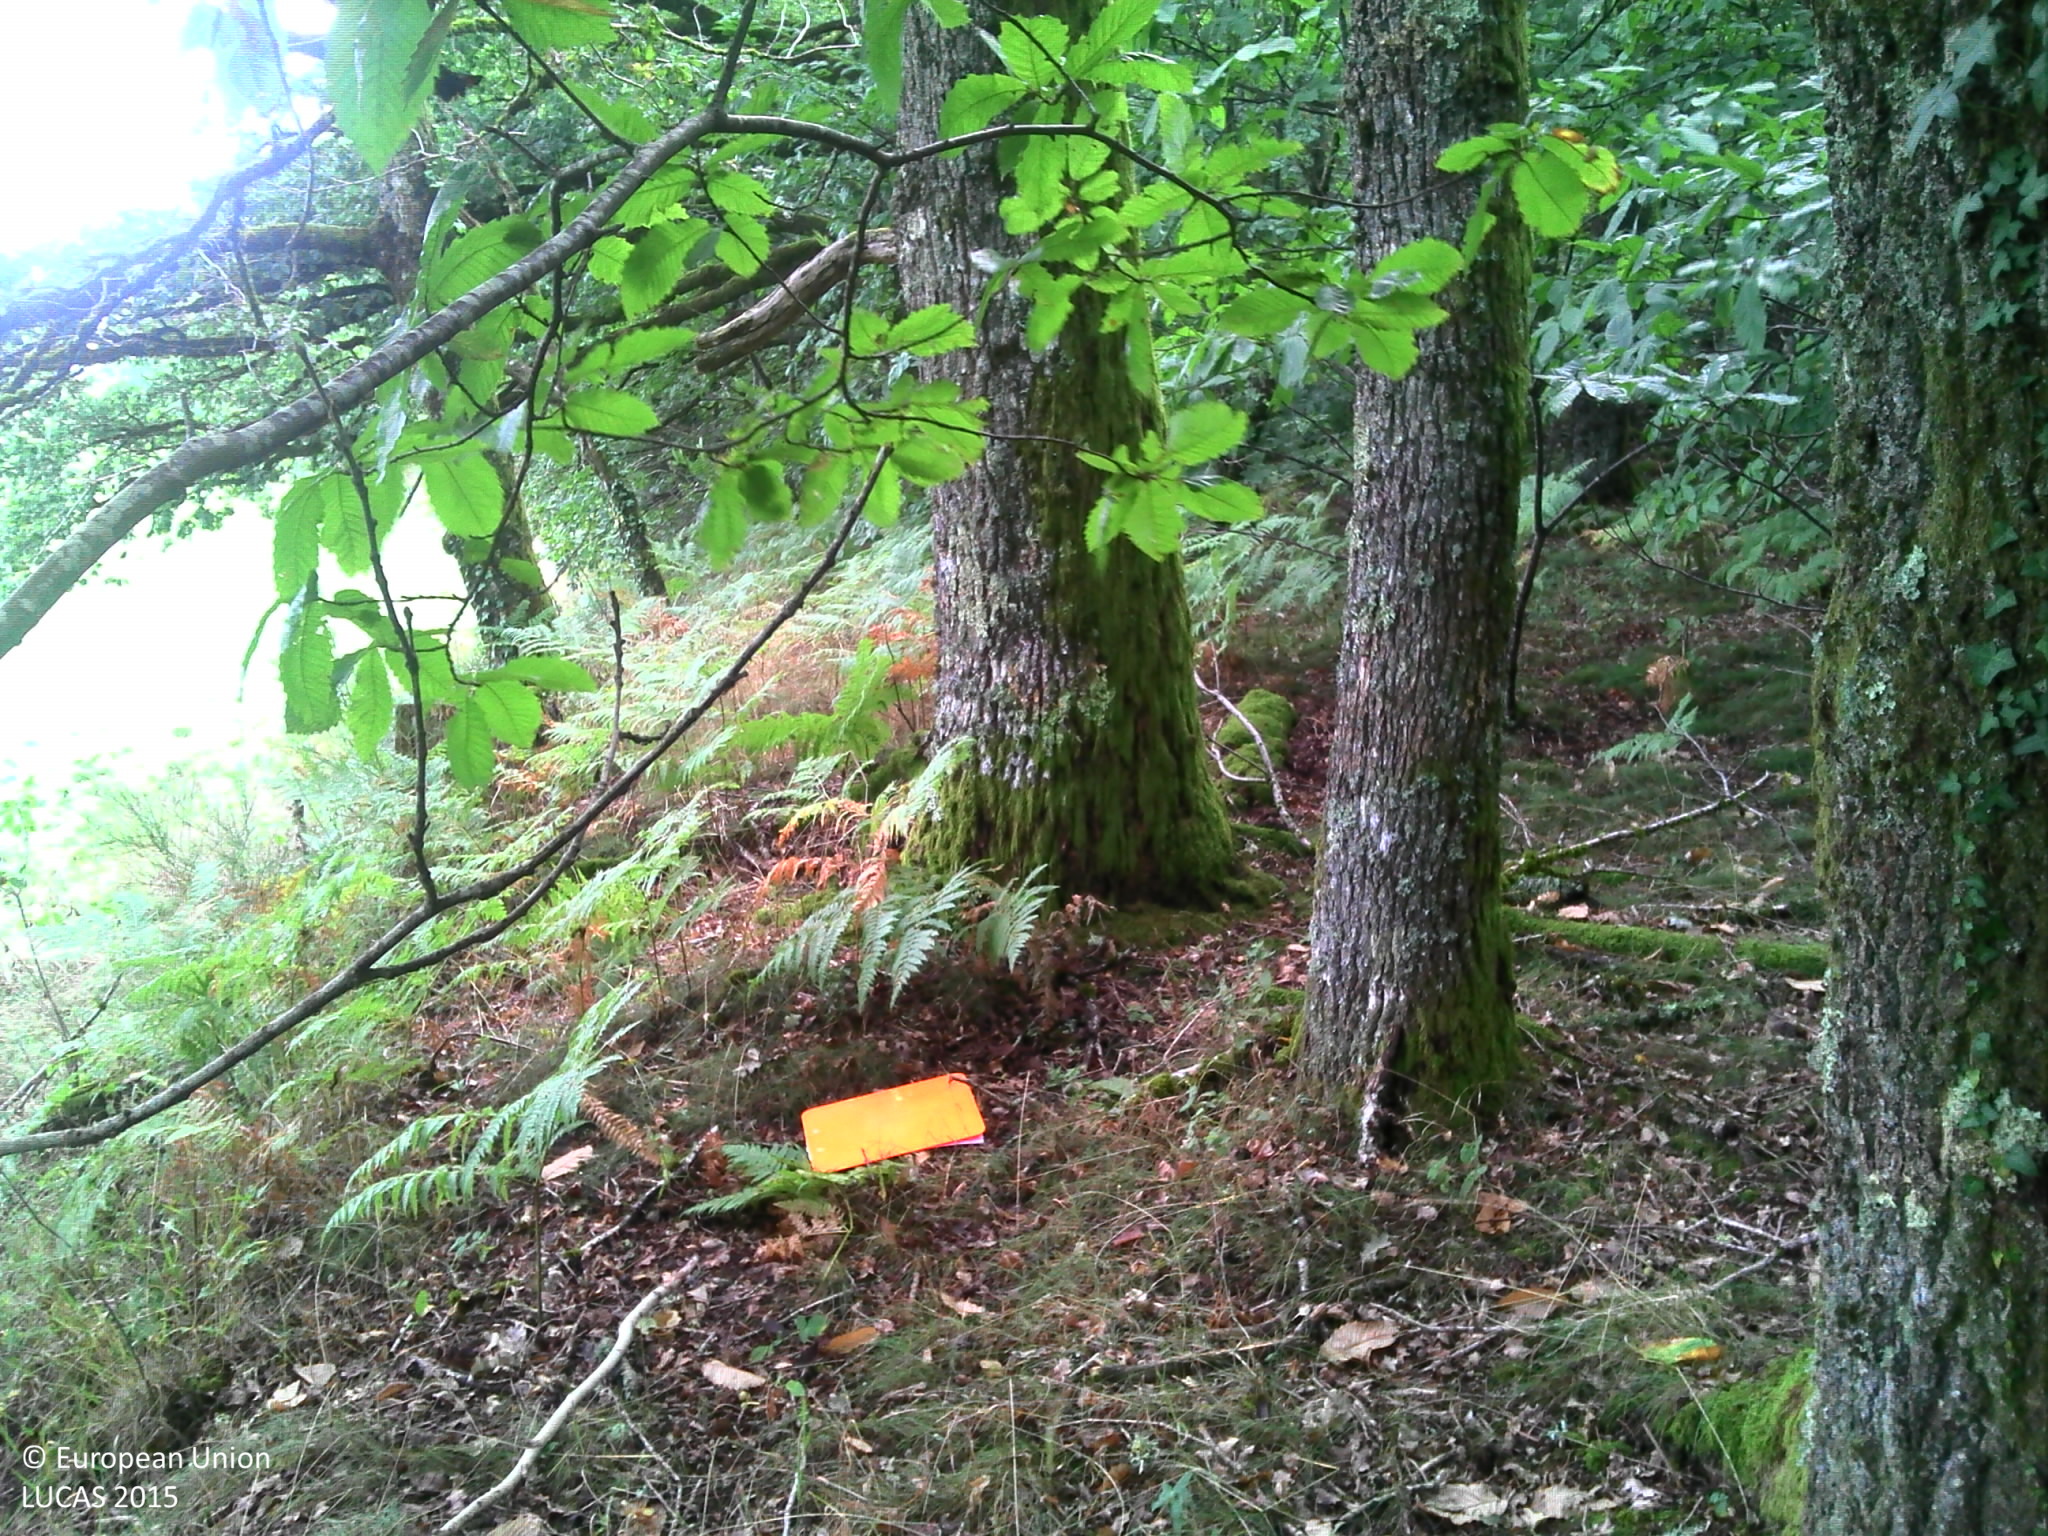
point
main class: Woodland
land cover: Broadleaved woodland
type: thermophilous deciduous forest
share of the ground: > 75 %
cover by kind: broadleaved forest trees 60 %, herbaceous plants 40 %
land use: Forestry
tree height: > 5 m
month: August
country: FR
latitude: 45.4406
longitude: 1.8265
